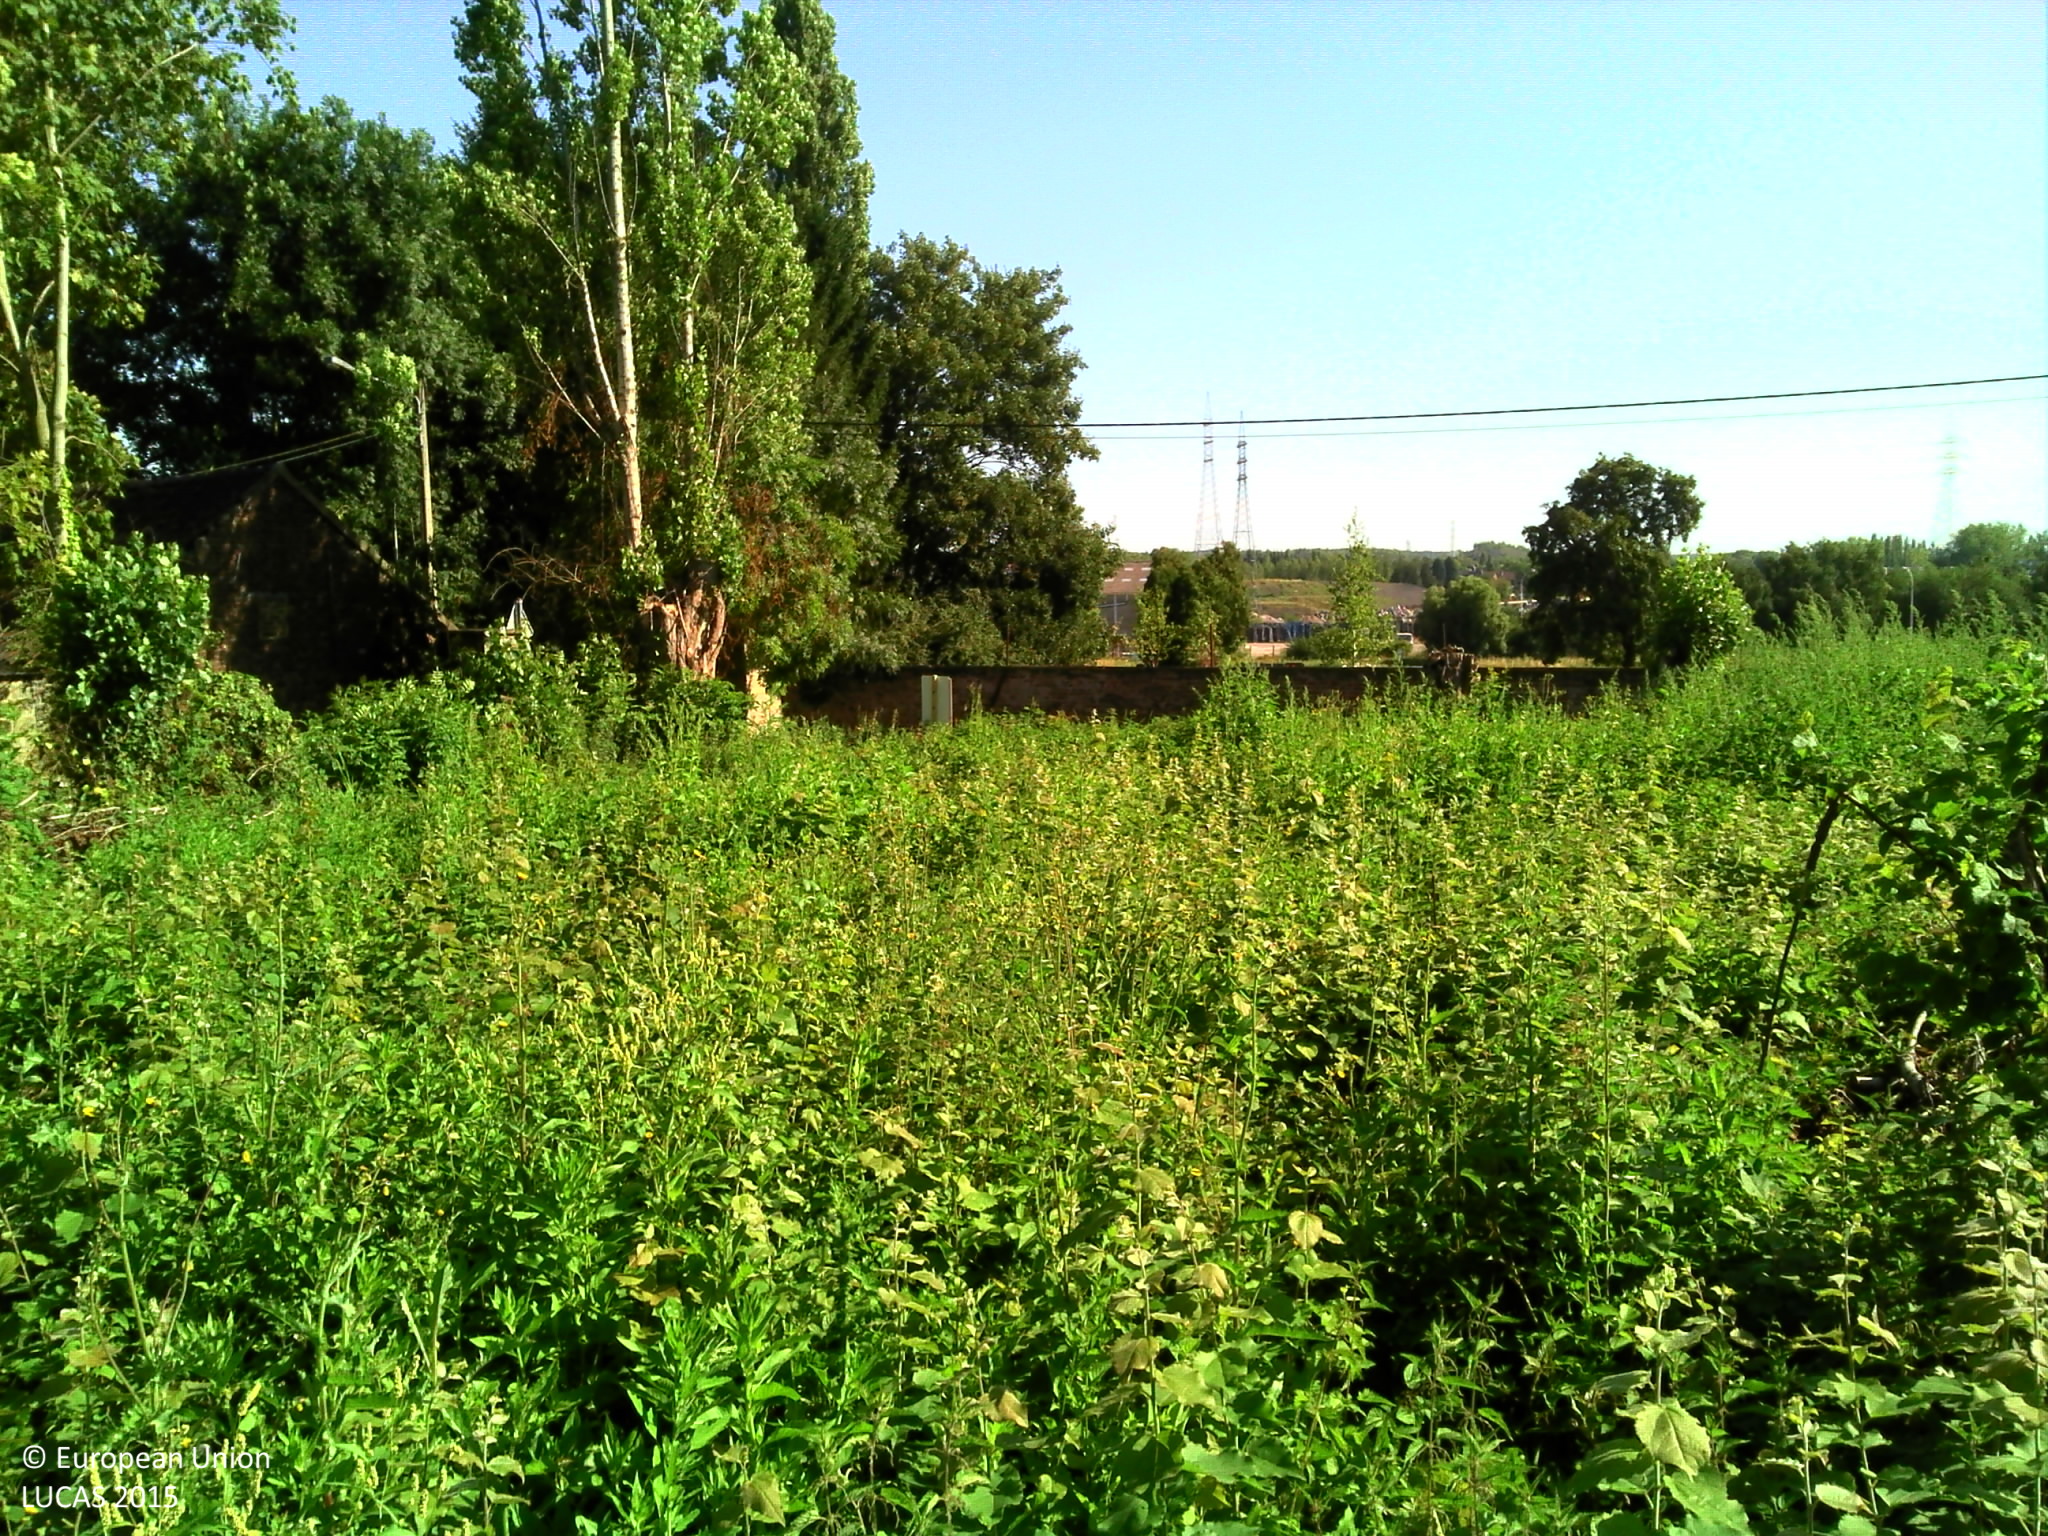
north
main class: Grassland
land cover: Spontaneously vegetated surfaces
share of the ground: > 75 %
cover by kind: herbaceous plants 95 %, shrubs 5 %
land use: Semi-natural and natural areas not in use
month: August
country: BE
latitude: 50.4144
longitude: 4.5498
